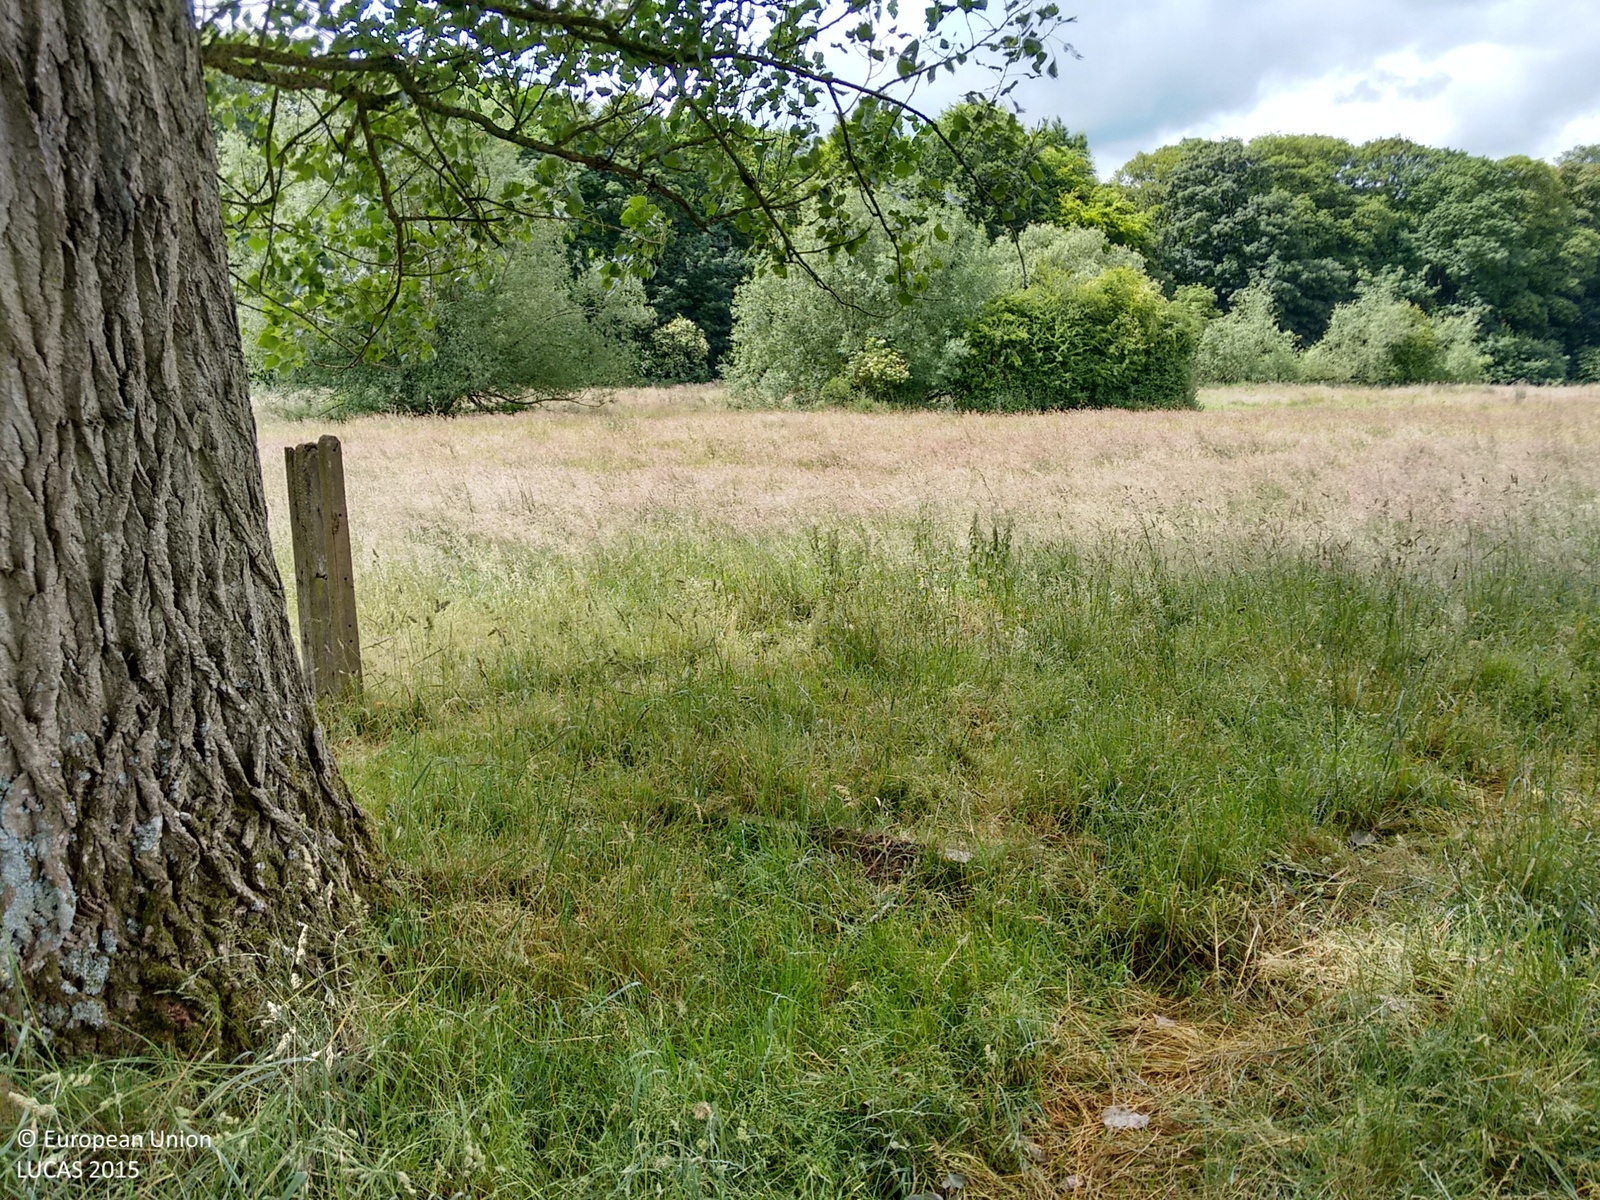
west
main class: Woodland
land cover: Broadleaved woodland
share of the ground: > 75 %
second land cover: Grassland without tree/shrub cover
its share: 10 - 25 %
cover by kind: broadleaved forest trees 80 %, herbaceous plants 20 %
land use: Waste treatment
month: June
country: GB
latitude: 51.4790
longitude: -1.2355
